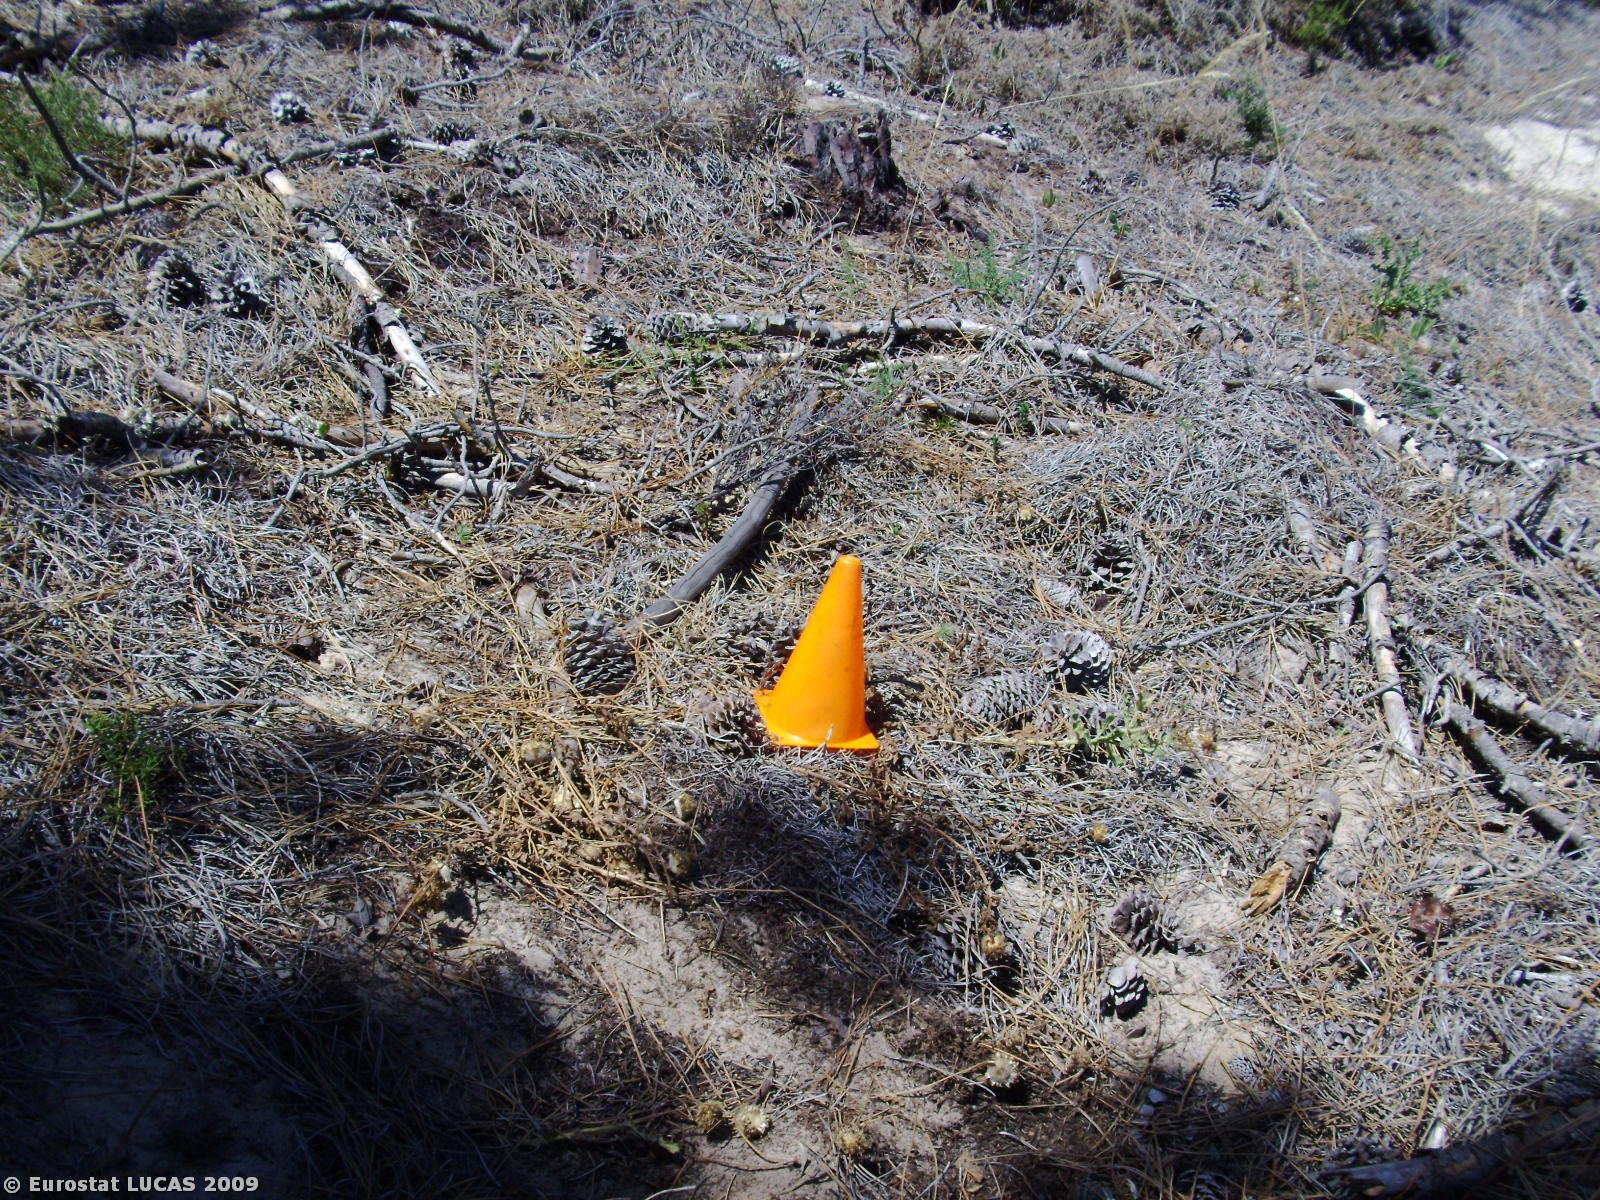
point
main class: Woodland
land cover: Coniferous woodland
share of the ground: > 75 %
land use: Unused
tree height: < 5 m
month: June
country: PT
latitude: 38.2141
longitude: -8.7741
